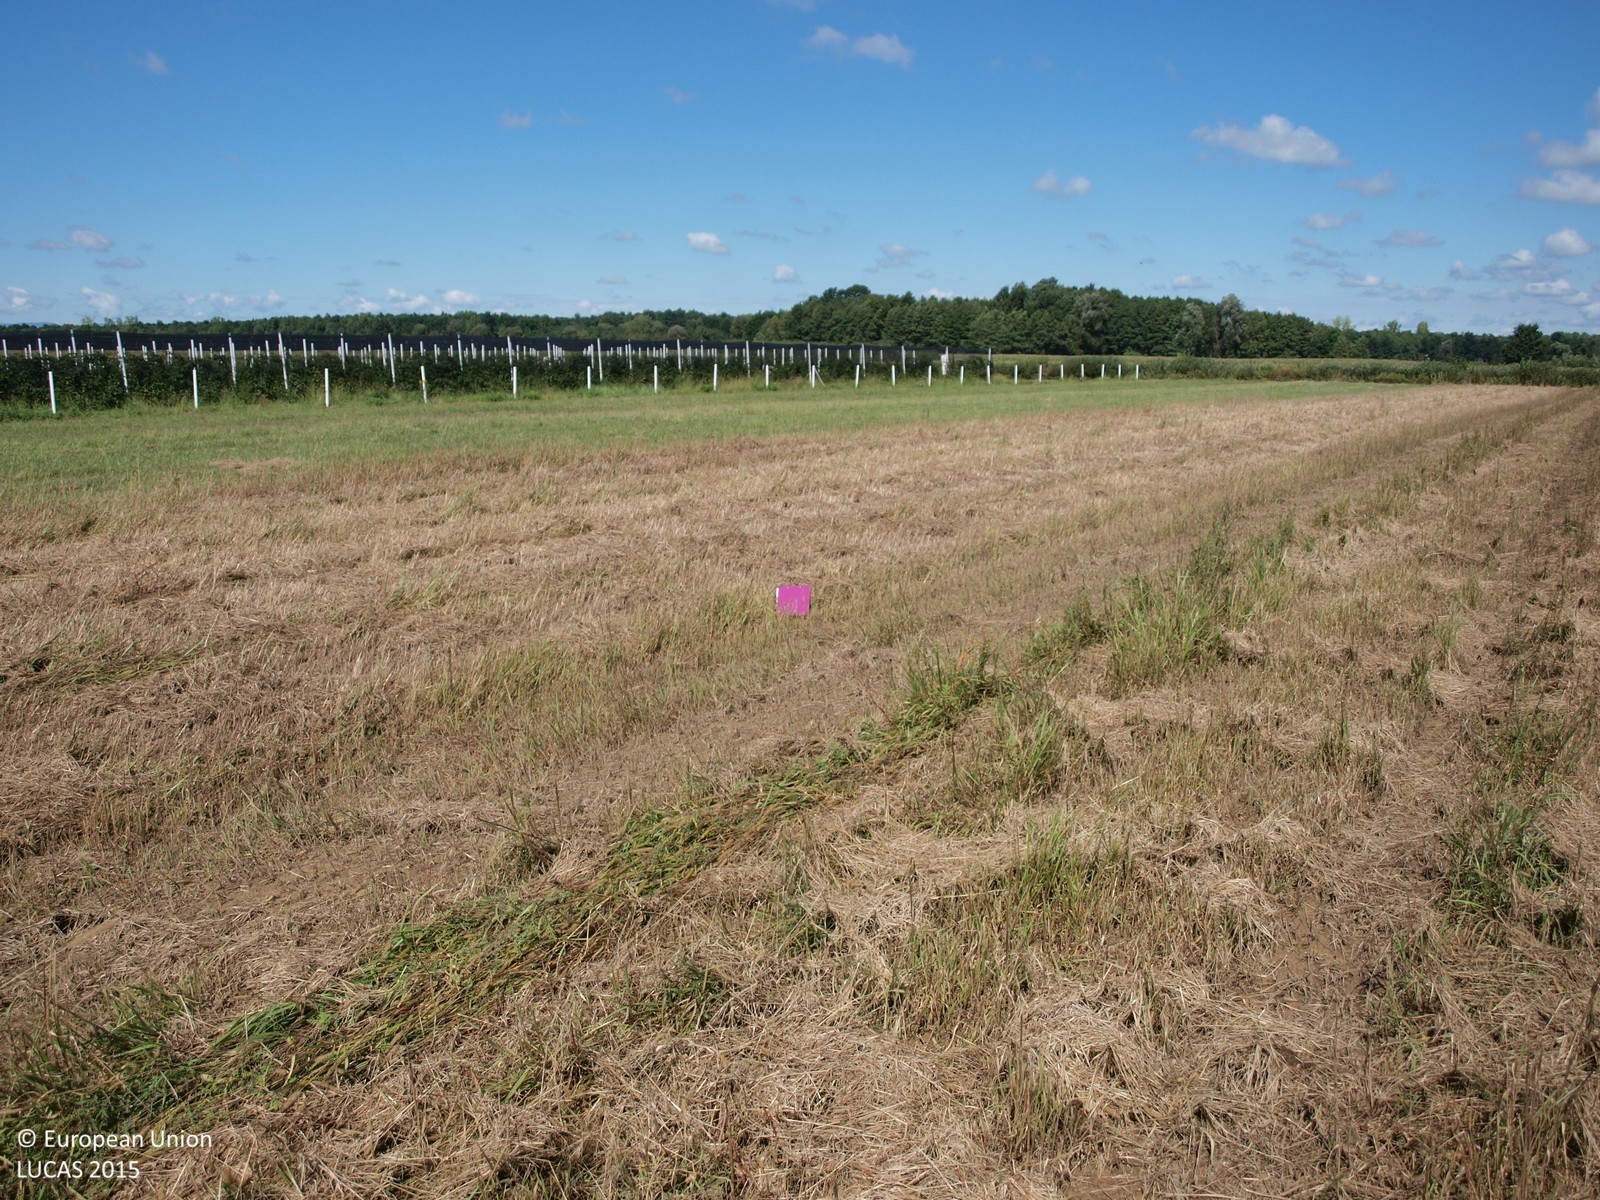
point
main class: Grassland
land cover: Grassland without tree/shrub cover
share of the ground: > 75 %
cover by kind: herbaceous plants 100 %
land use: Agriculture (excluding fallow land and kitchen gardens)
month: September
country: HR
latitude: 45.7791
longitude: 16.4166
